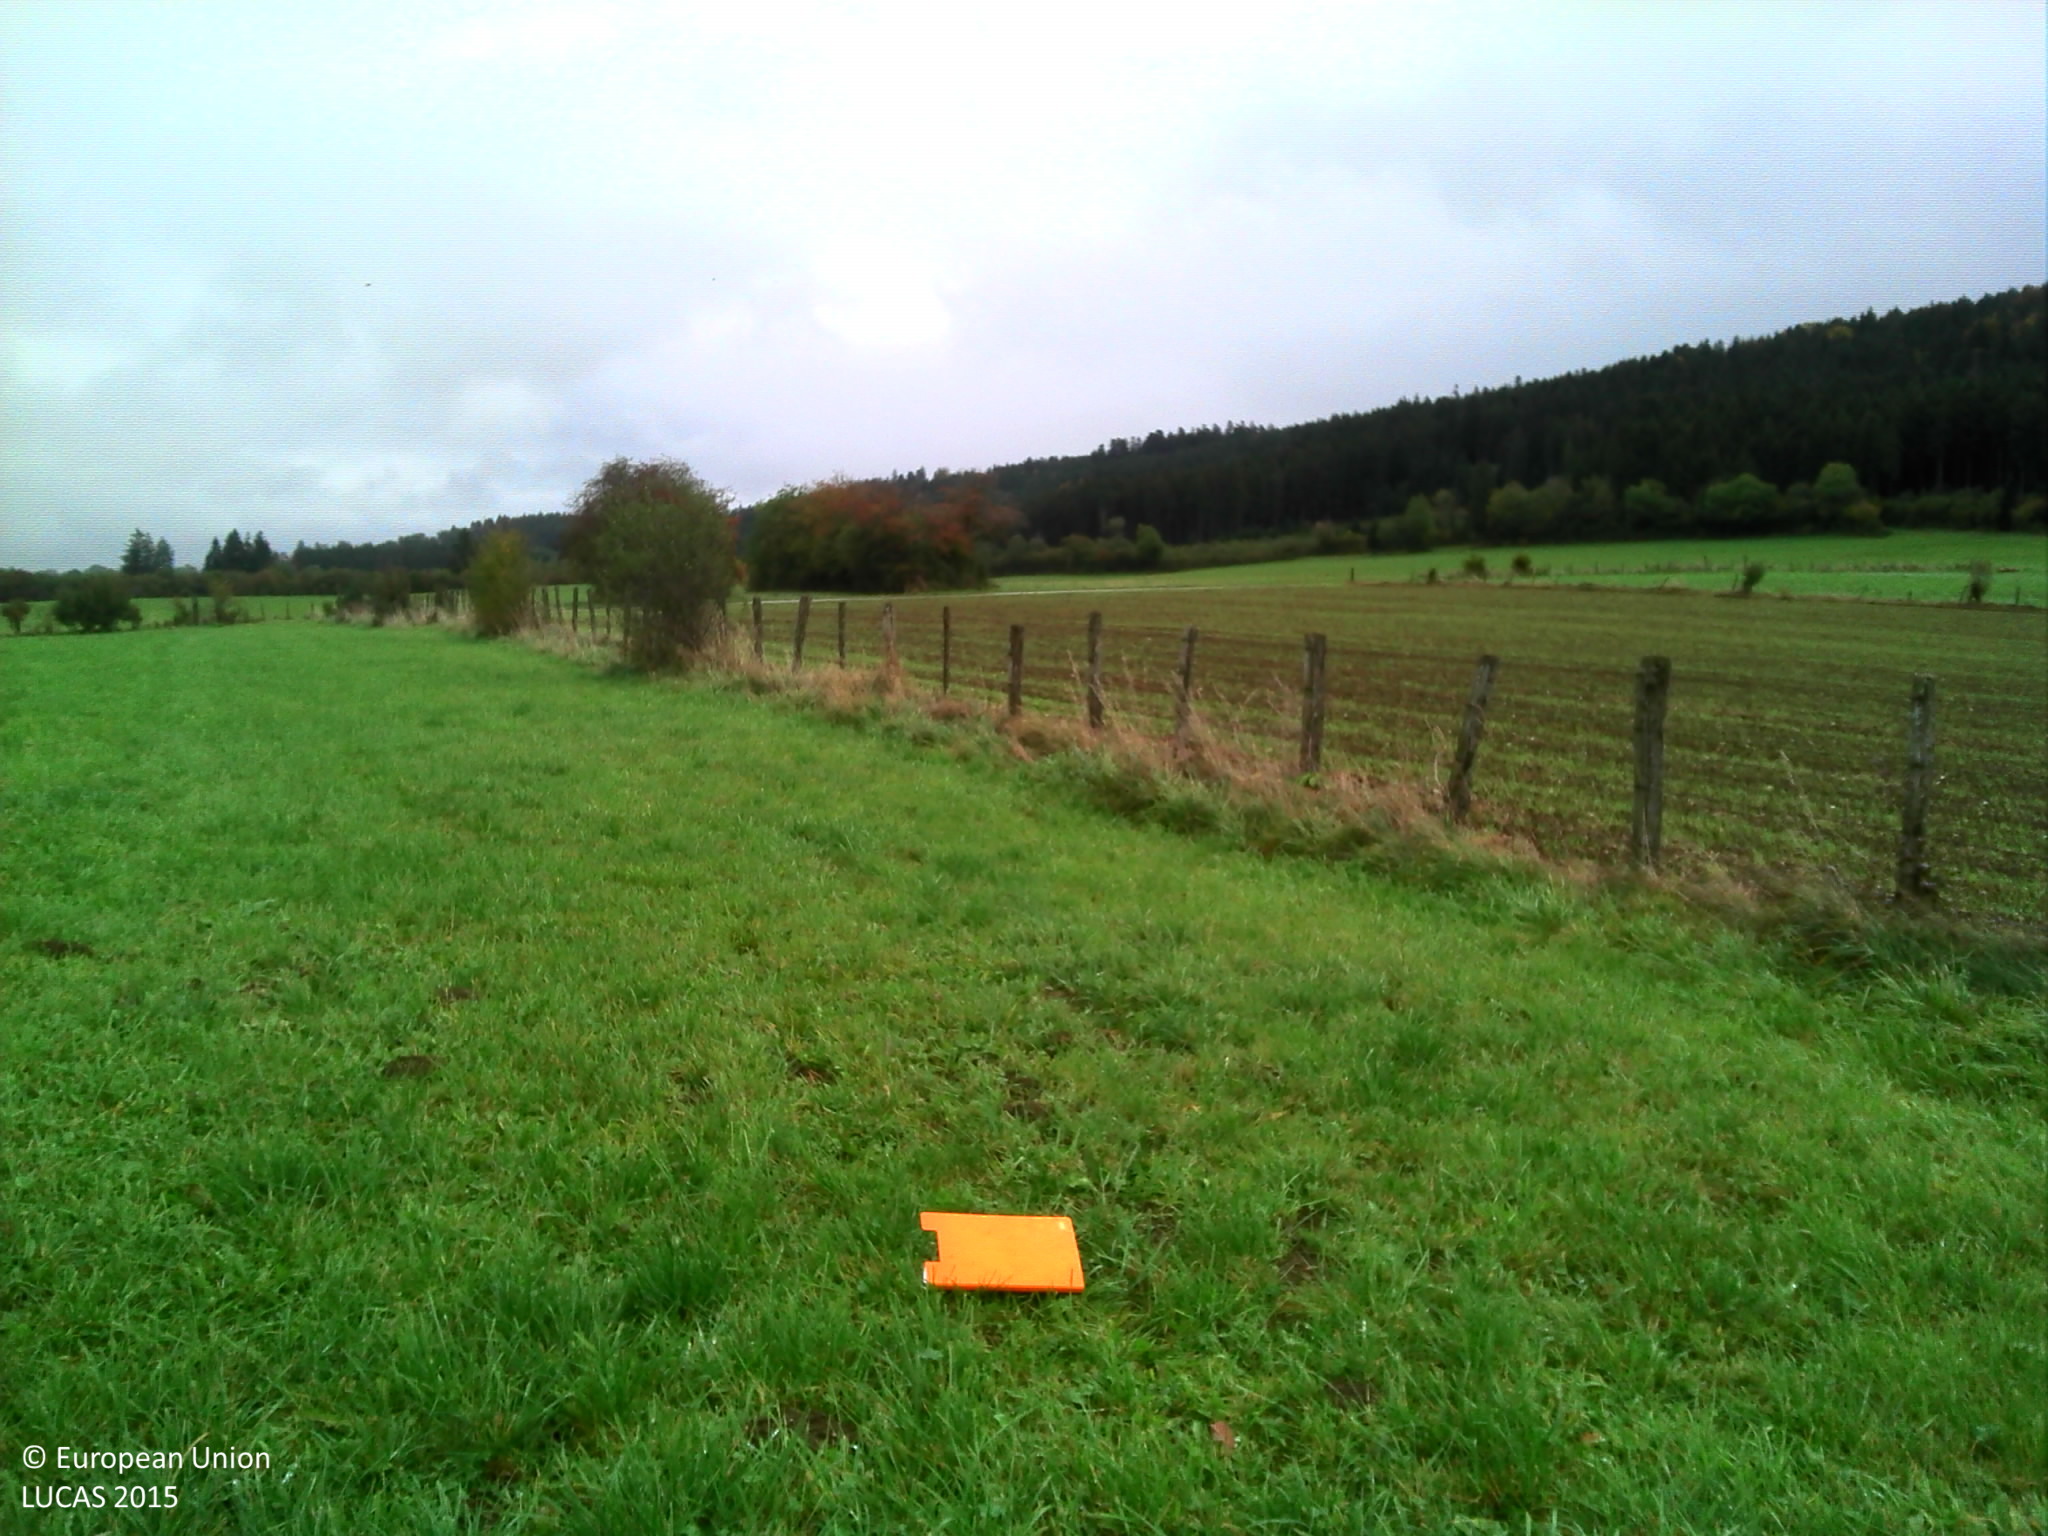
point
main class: Grassland
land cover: Grassland without tree/shrub cover
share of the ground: > 75 %
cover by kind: herbaceous plants 100 %
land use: Agriculture (excluding fallow land and kitchen gardens)
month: October
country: FR
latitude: 46.9481
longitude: 6.1264
